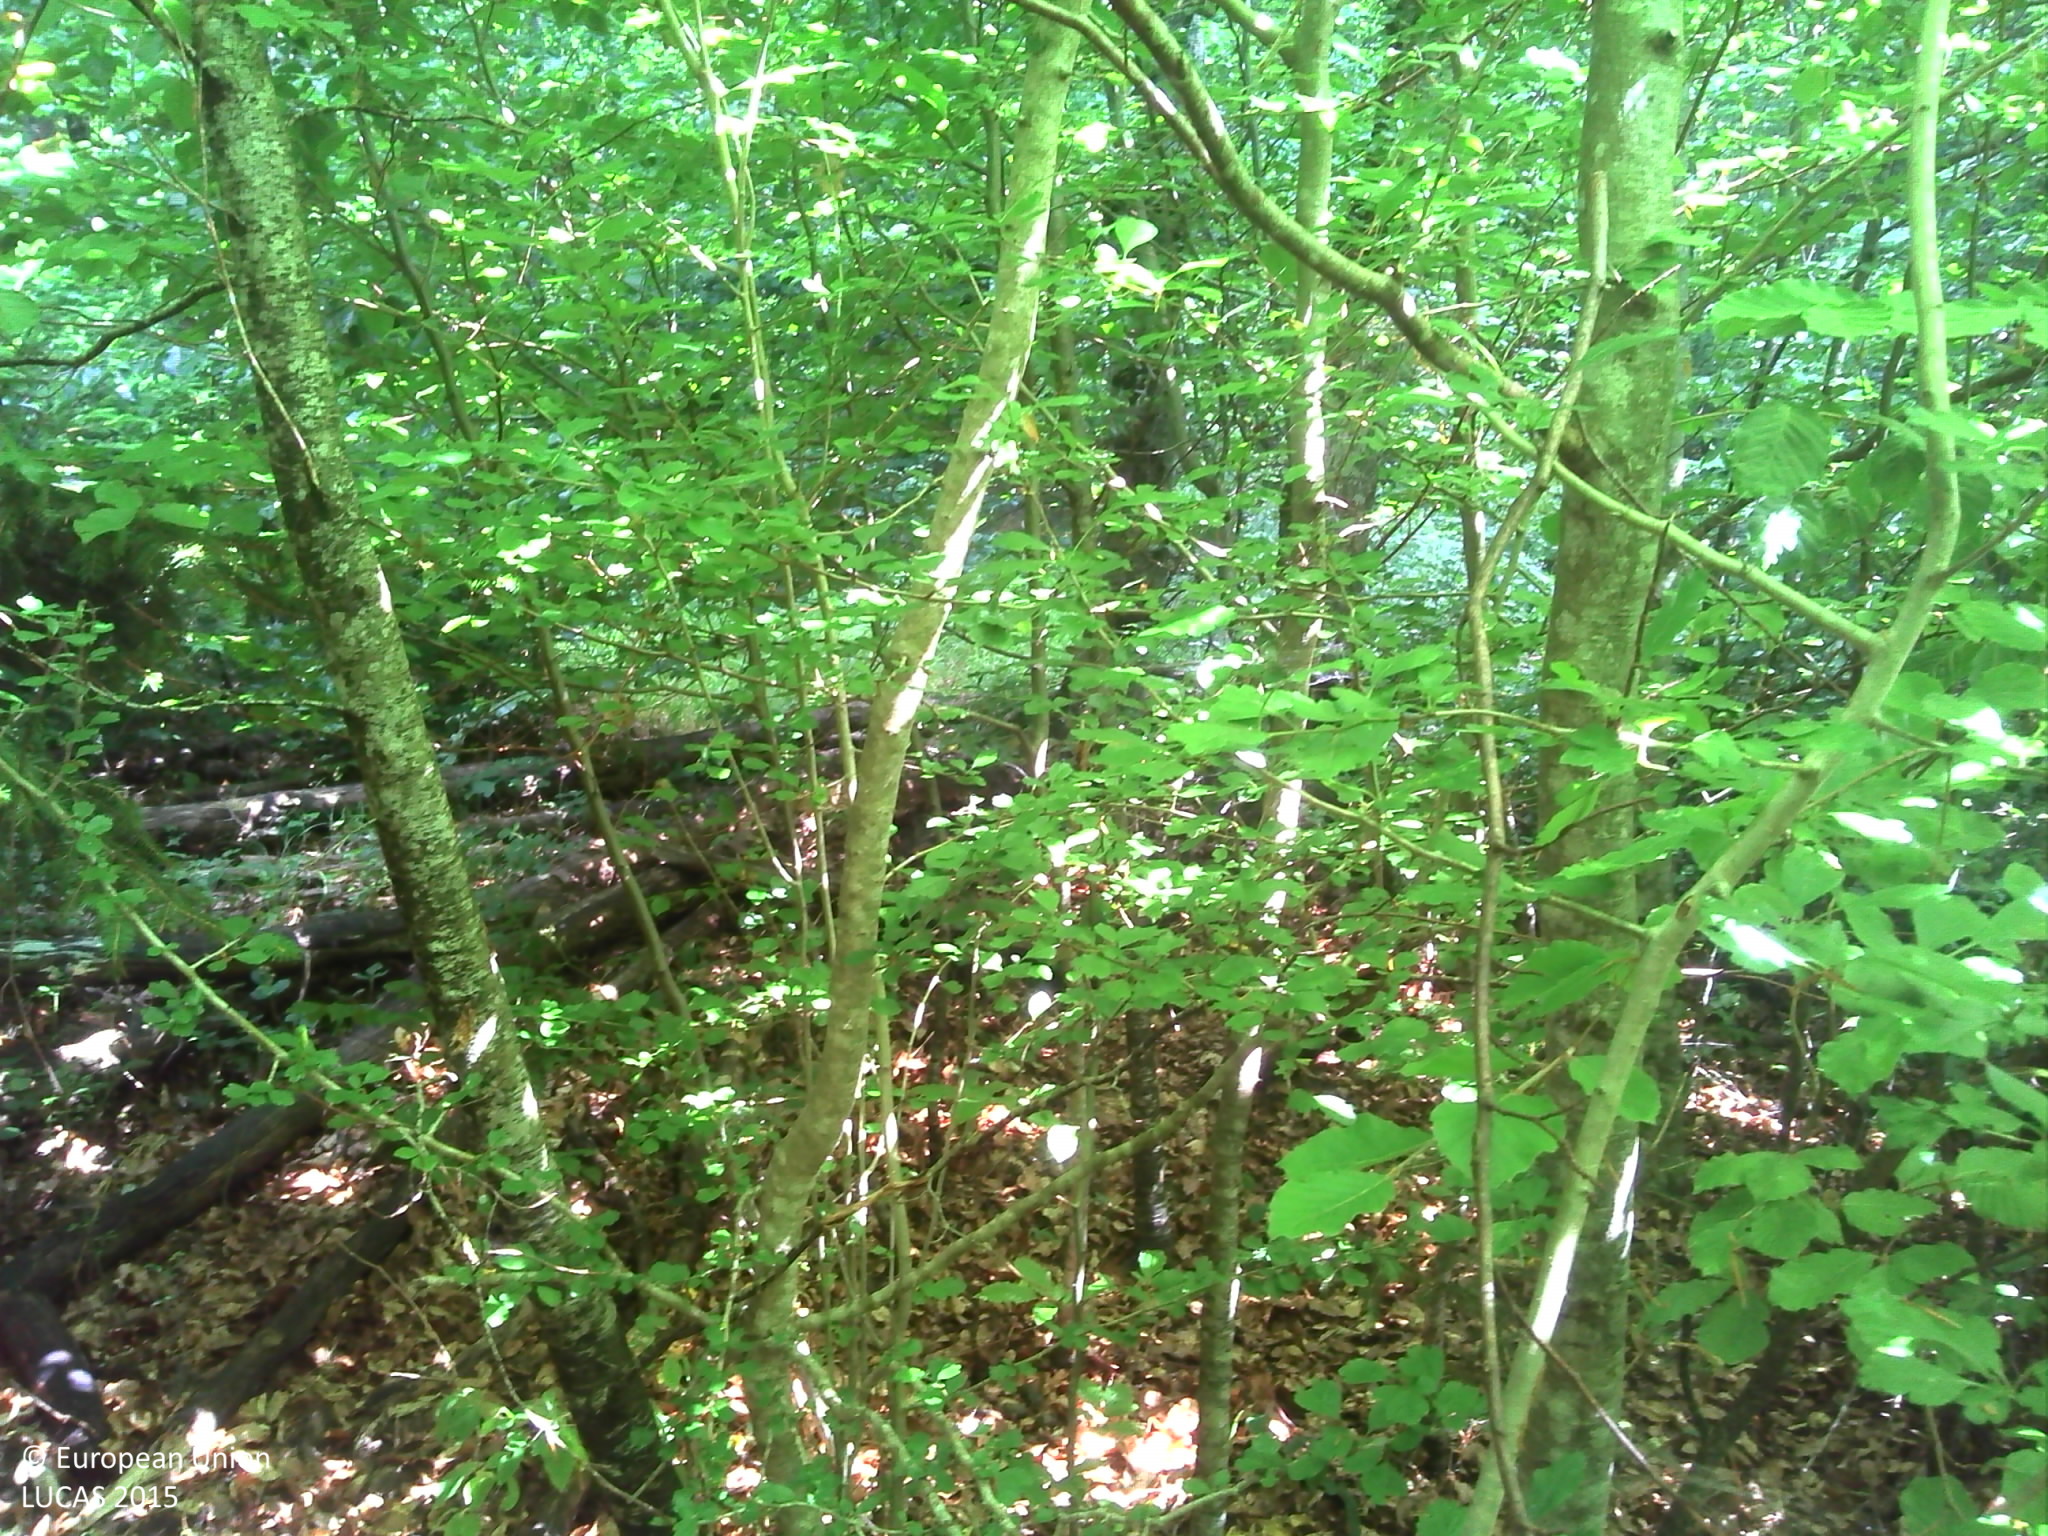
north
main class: Woodland
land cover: Spruce dominated mixed woodland
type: beech forest
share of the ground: > 75 %
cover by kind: broadleaved forest trees 40 %, coniferous forest trees 35 %, herbaceous plants 20 %, lichens and mosses 5 %
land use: Forestry
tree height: > 5 m
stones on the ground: < 10 %
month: July
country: FR
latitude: 46.2189
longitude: 6.4125
